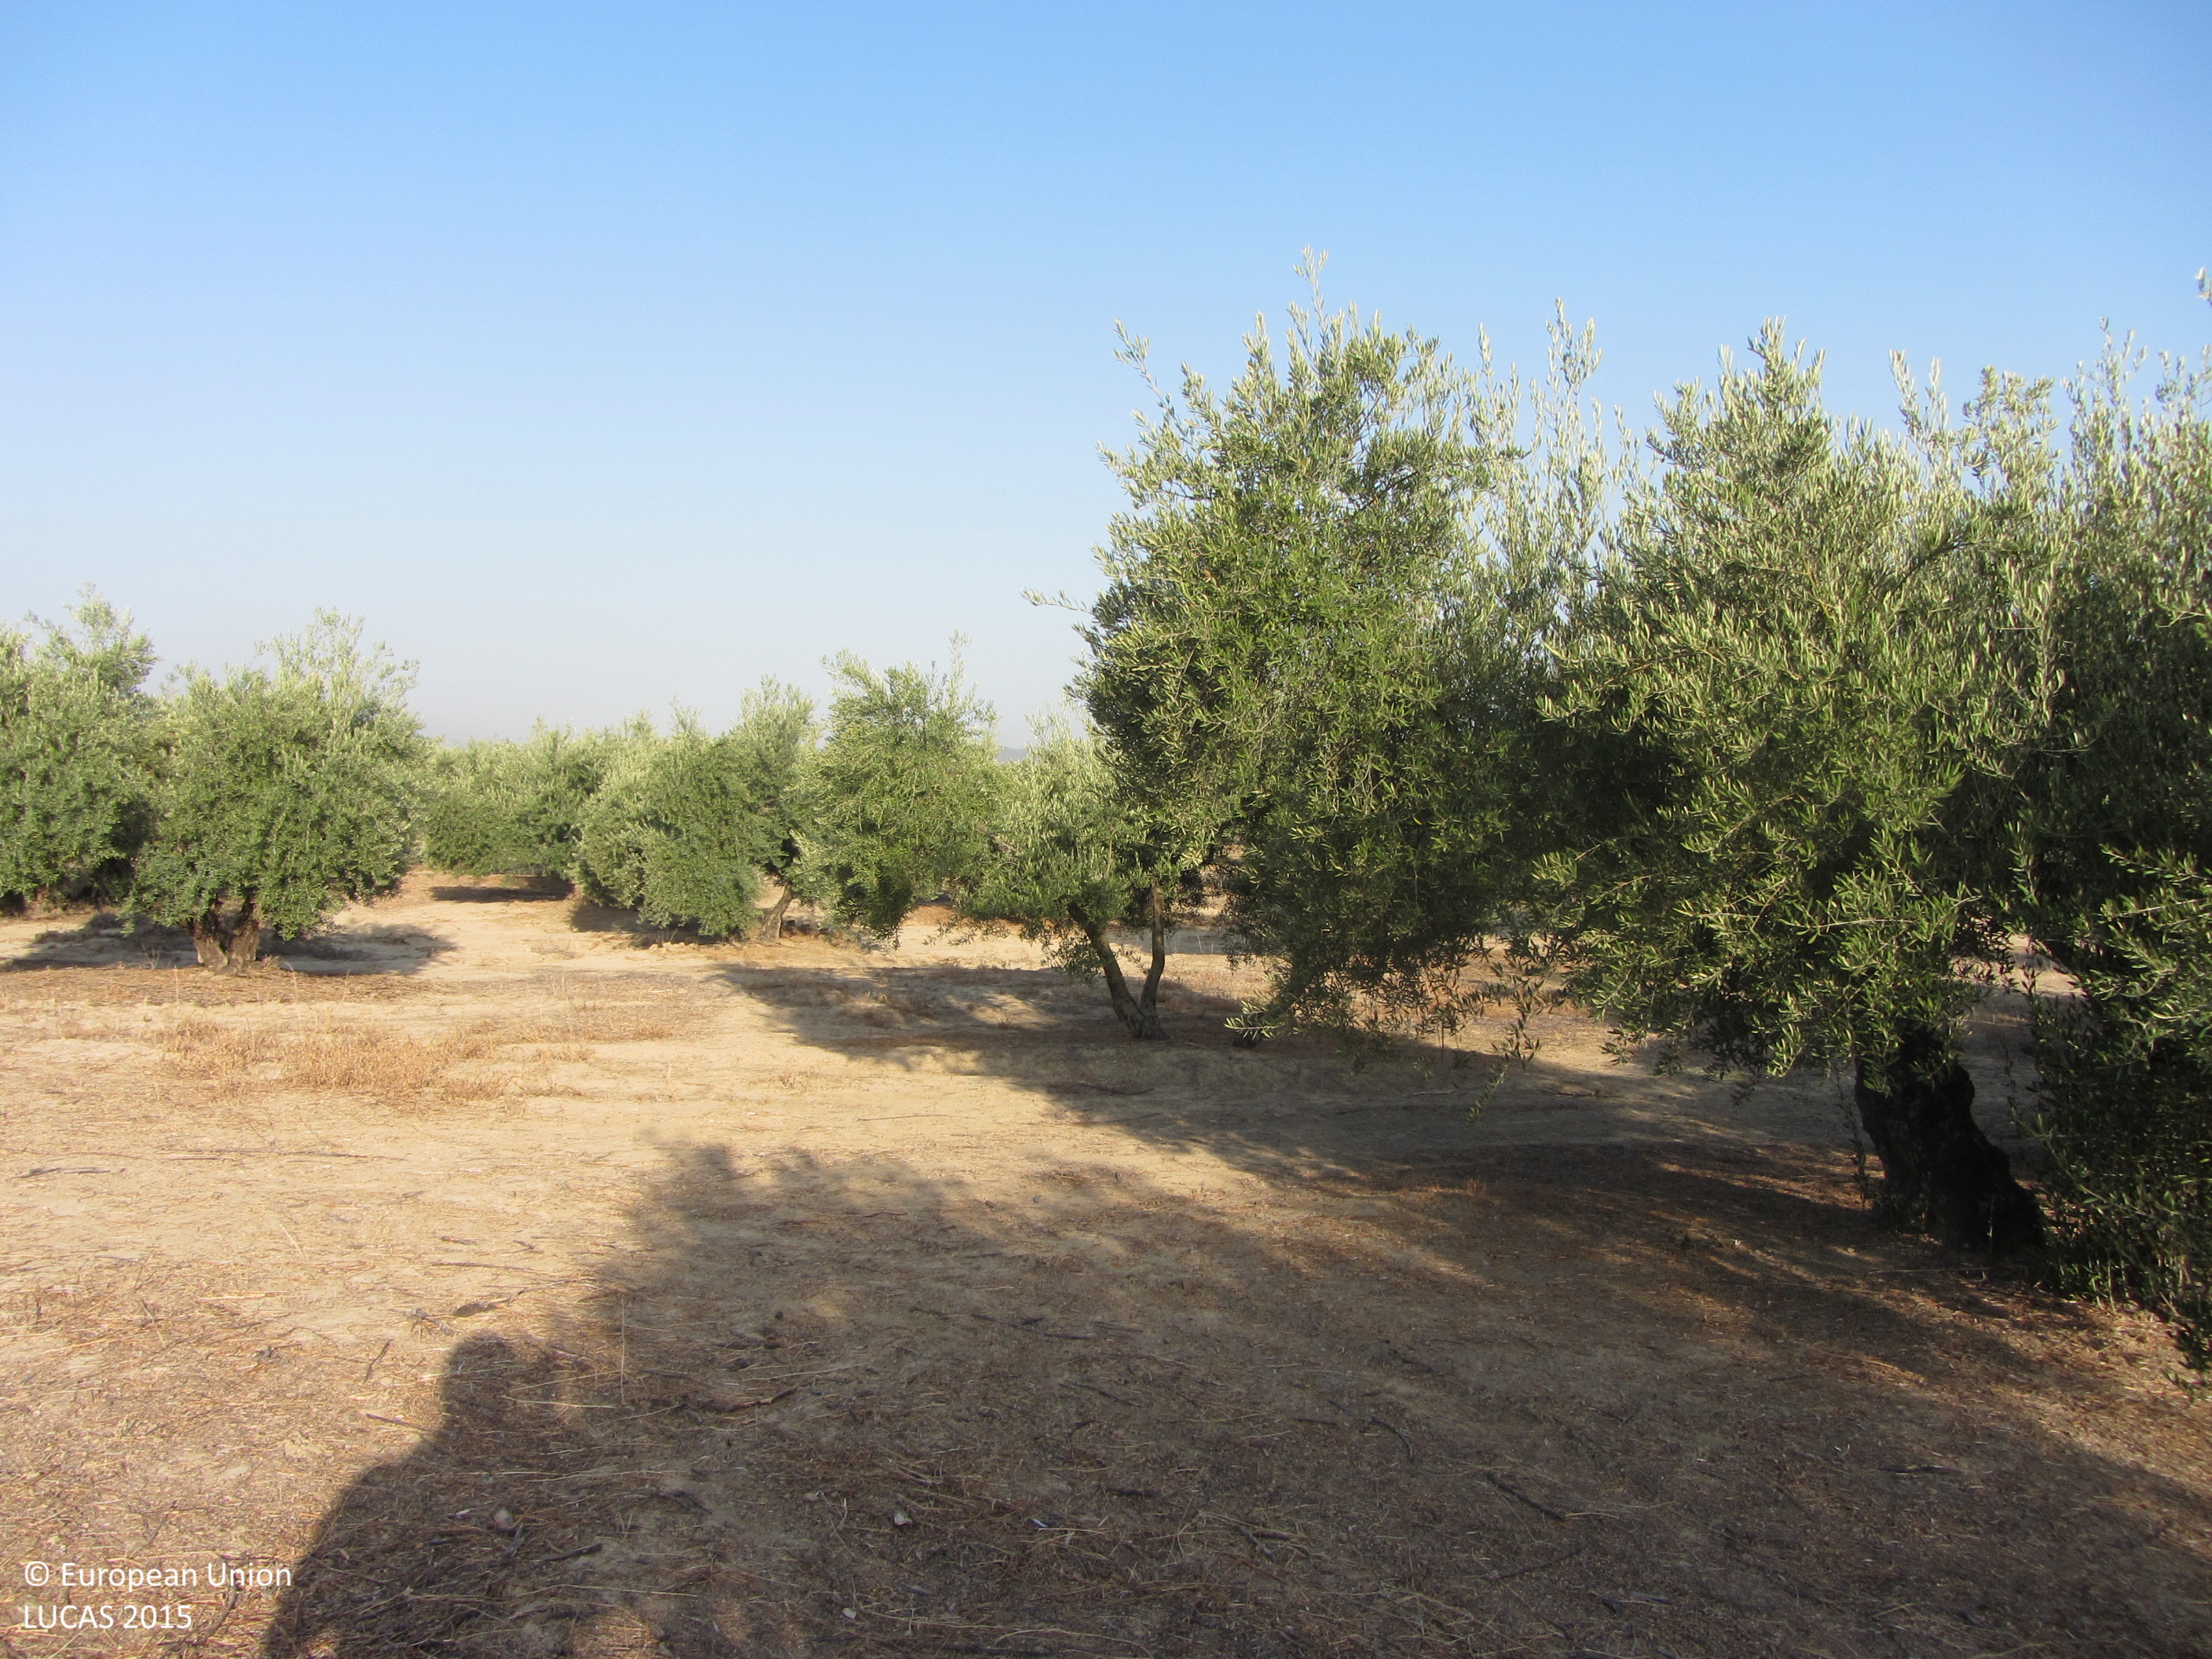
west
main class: Cropland
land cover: Olive groves
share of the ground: 25 - 50 %
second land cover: Spontaneously vegetated surfaces
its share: 10 - 25 %
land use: Agriculture (excluding fallow land and kitchen gardens)
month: July
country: ES
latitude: 37.9086
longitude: -4.1905
